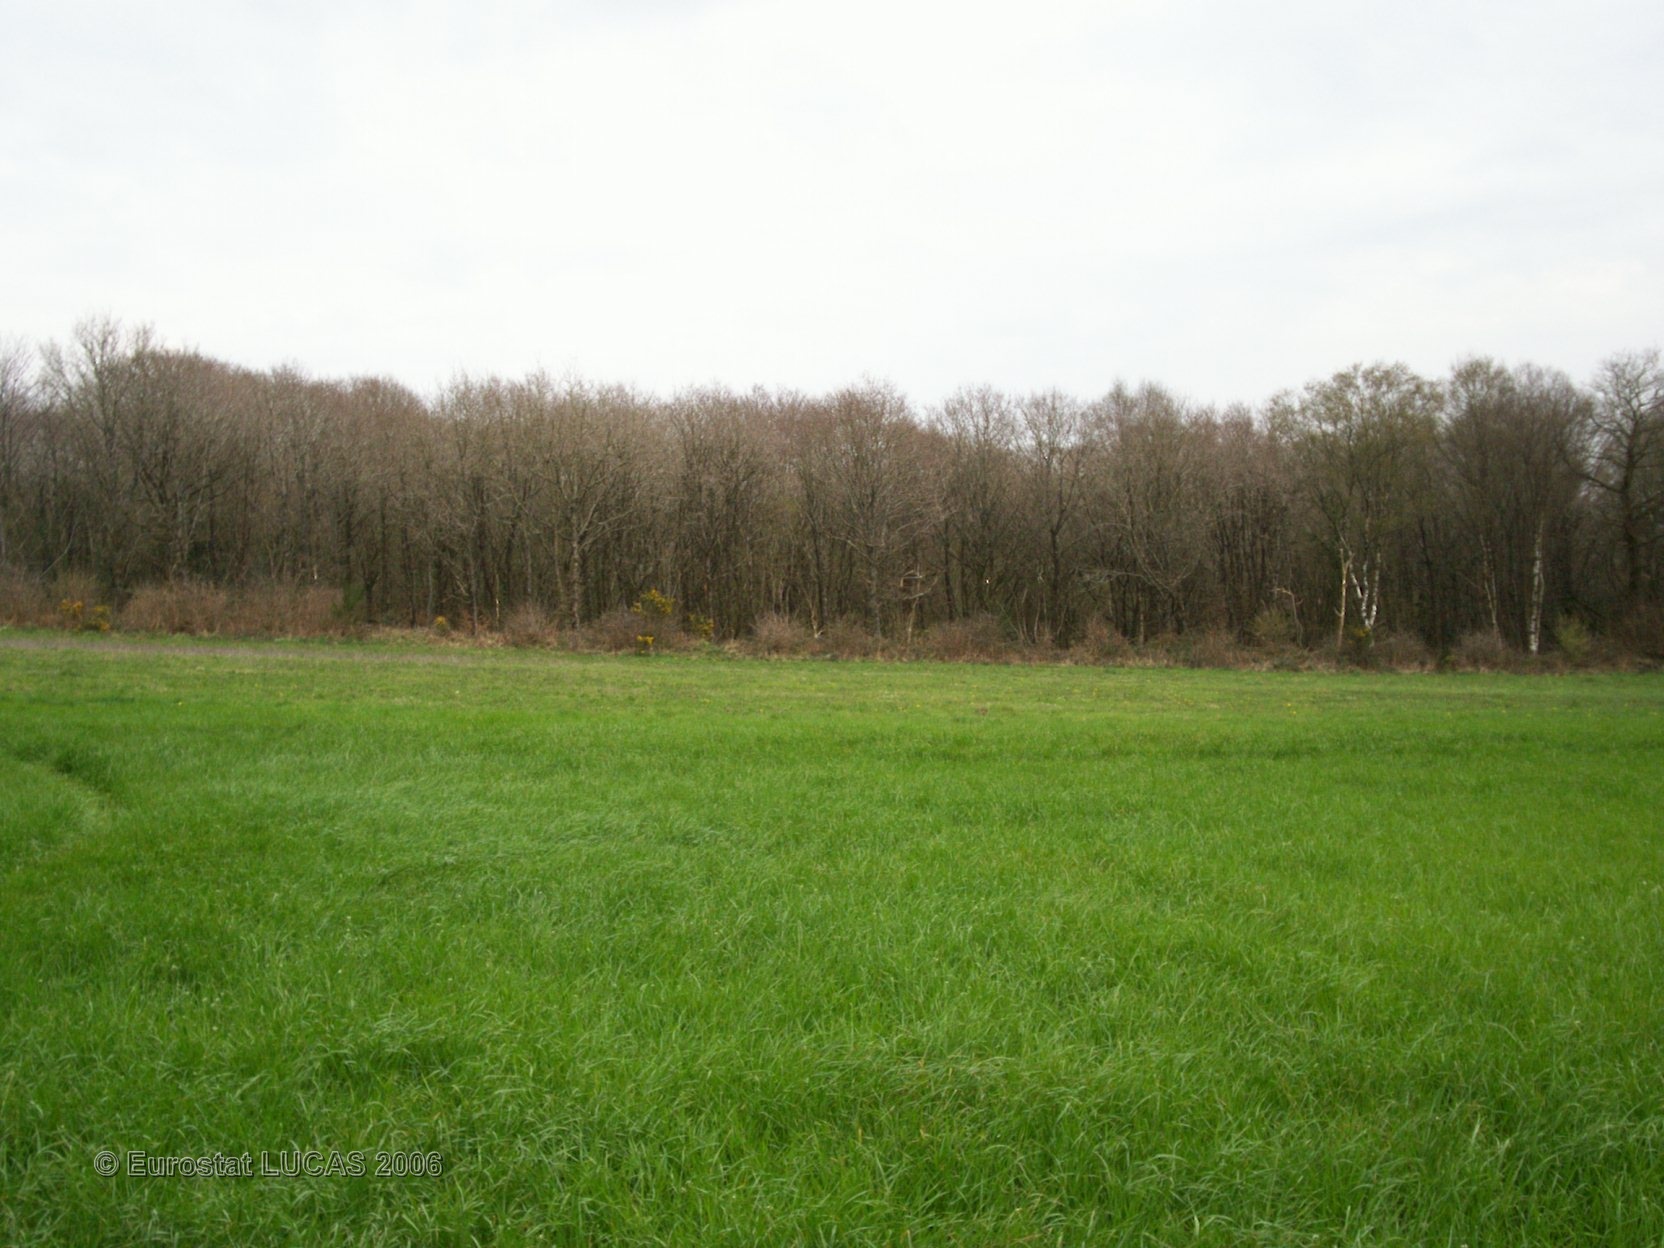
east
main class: Grassland
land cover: Grassland without tree/shrub cover
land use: Agriculture (excluding fallow land and kitchen gardens)
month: April
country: FR
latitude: 48.4791
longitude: -3.6780
